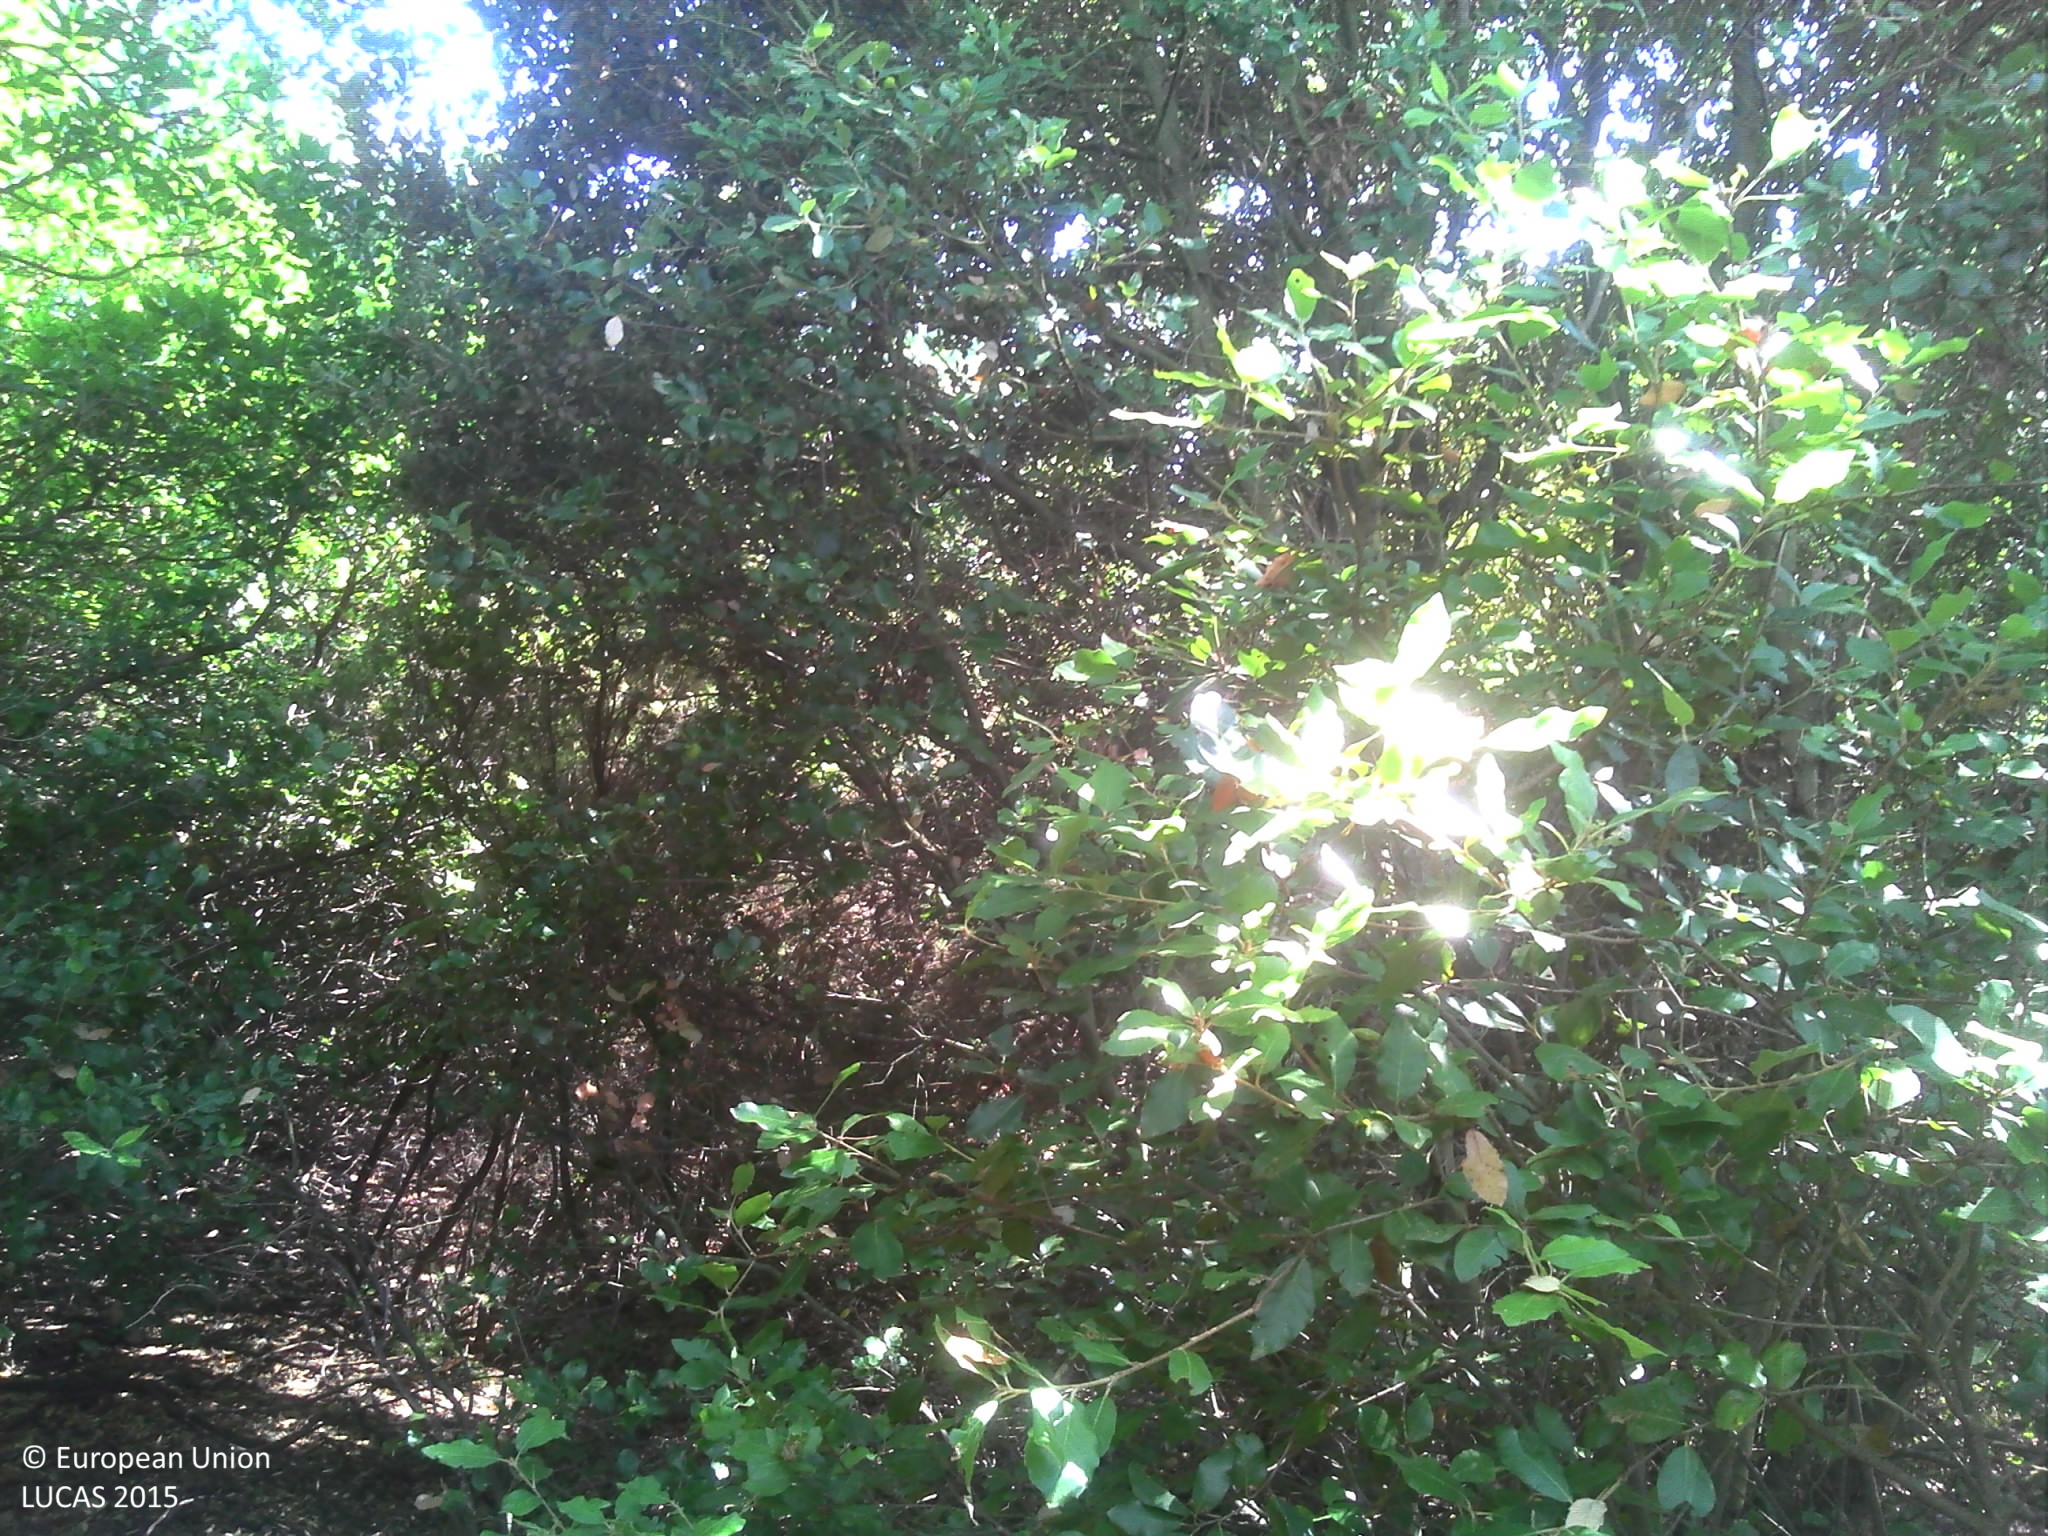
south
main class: Woodland
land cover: Broadleaved woodland
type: thermophilous deciduous forest
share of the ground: > 75 %
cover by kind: broadleaved forest trees 90 %, unconsolidated bare surface 10 %
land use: Semi-natural and natural areas not in use
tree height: > 5 m
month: July
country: FR
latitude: 43.1677
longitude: 6.3809
